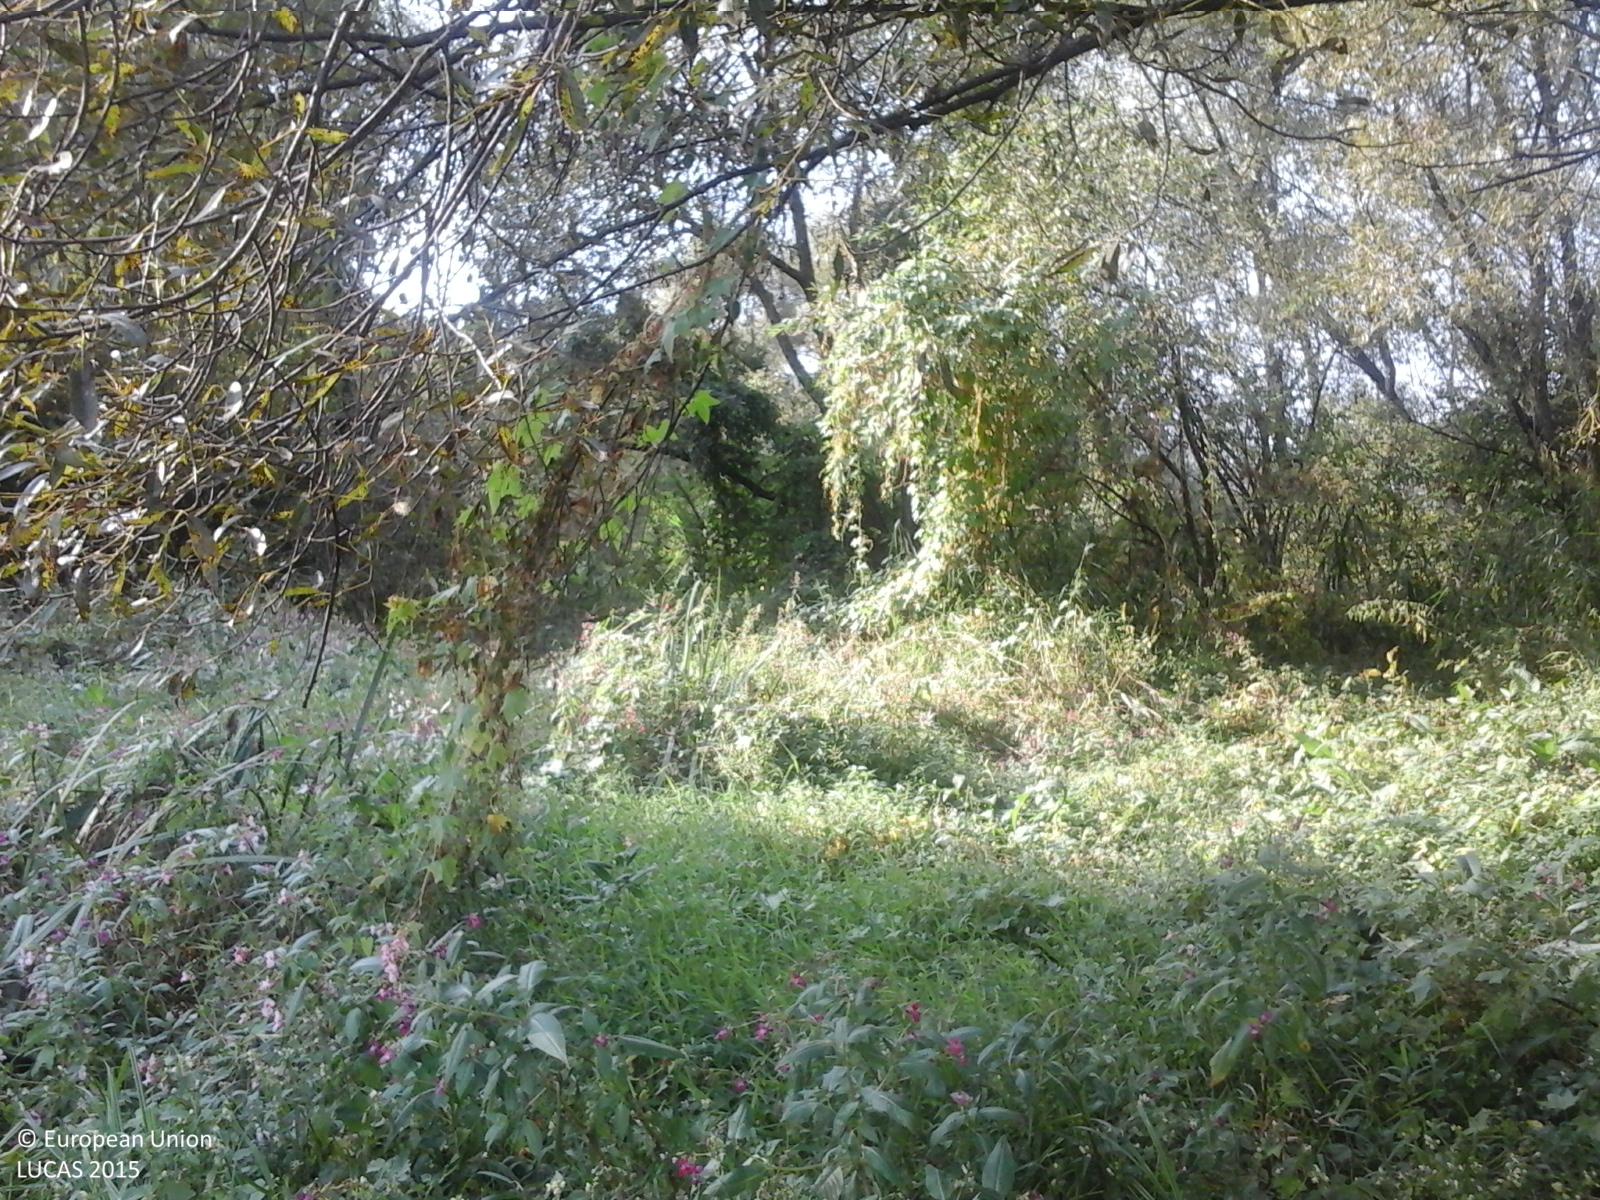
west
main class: Grassland
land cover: Spontaneously vegetated surfaces
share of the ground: > 75 %
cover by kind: herbaceous plants 100 %
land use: Fallow land
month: September
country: RO
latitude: 47.9829
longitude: 23.7063
